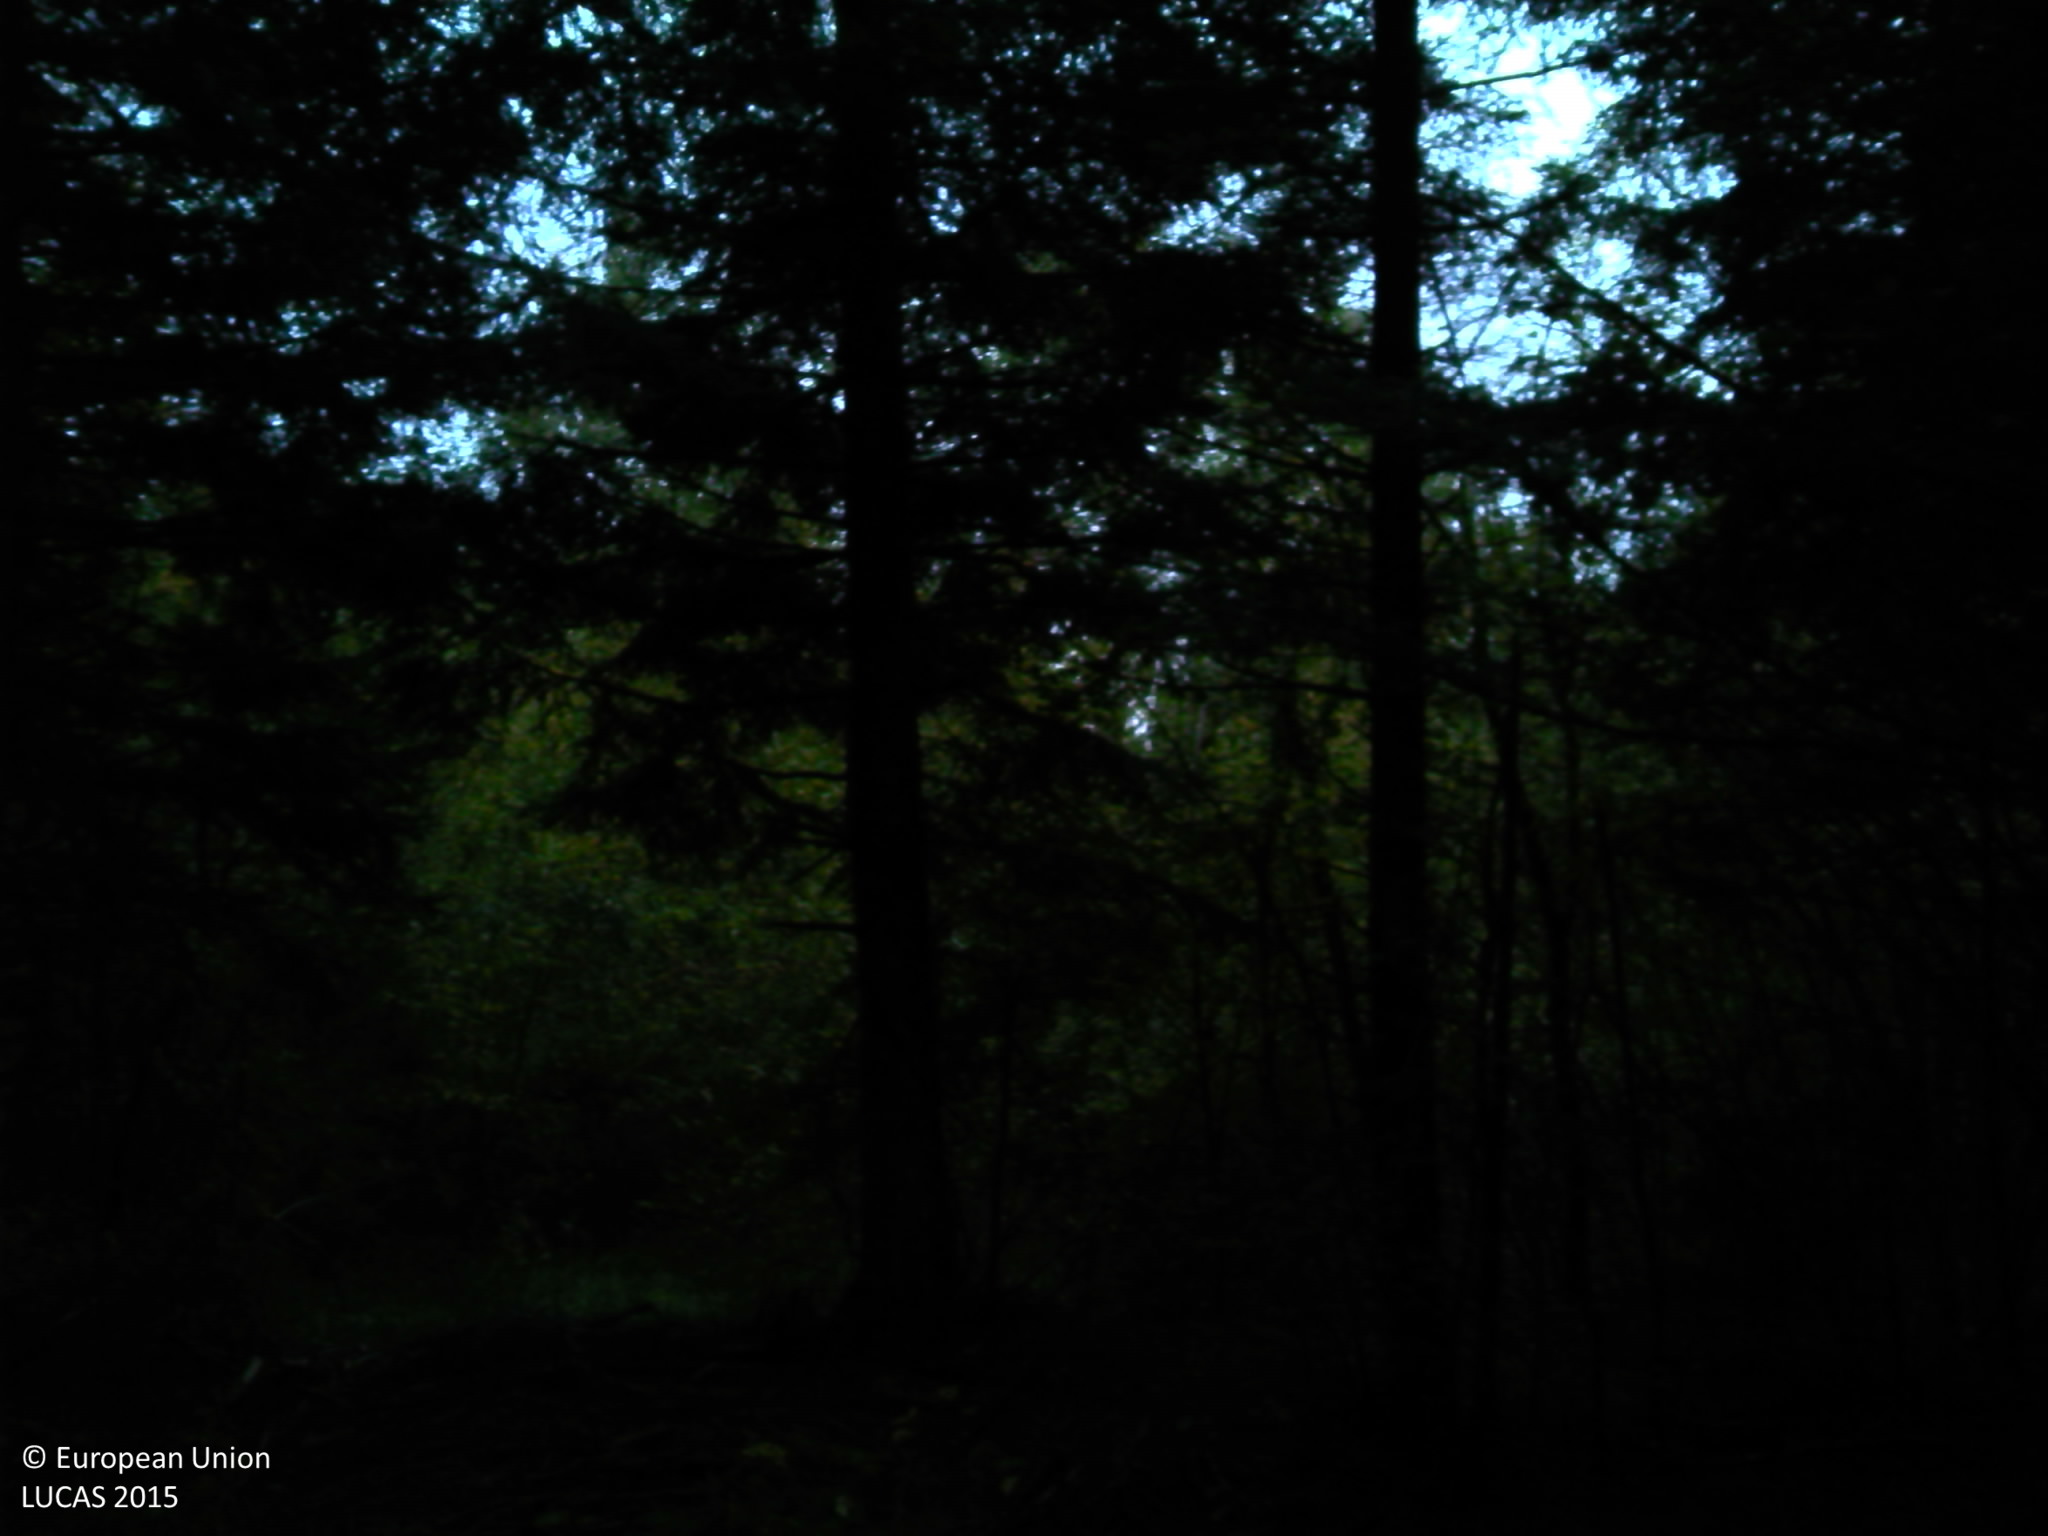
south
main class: Woodland
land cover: Spruce dominated mixed woodland
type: mountainous beech forest
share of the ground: > 75 %
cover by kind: coniferous forest trees 40 %, broadleaved forest trees 40 %, shrubs 20 %
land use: Forestry
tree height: > 5 m
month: October
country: FR
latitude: 46.8583
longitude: 6.1330
